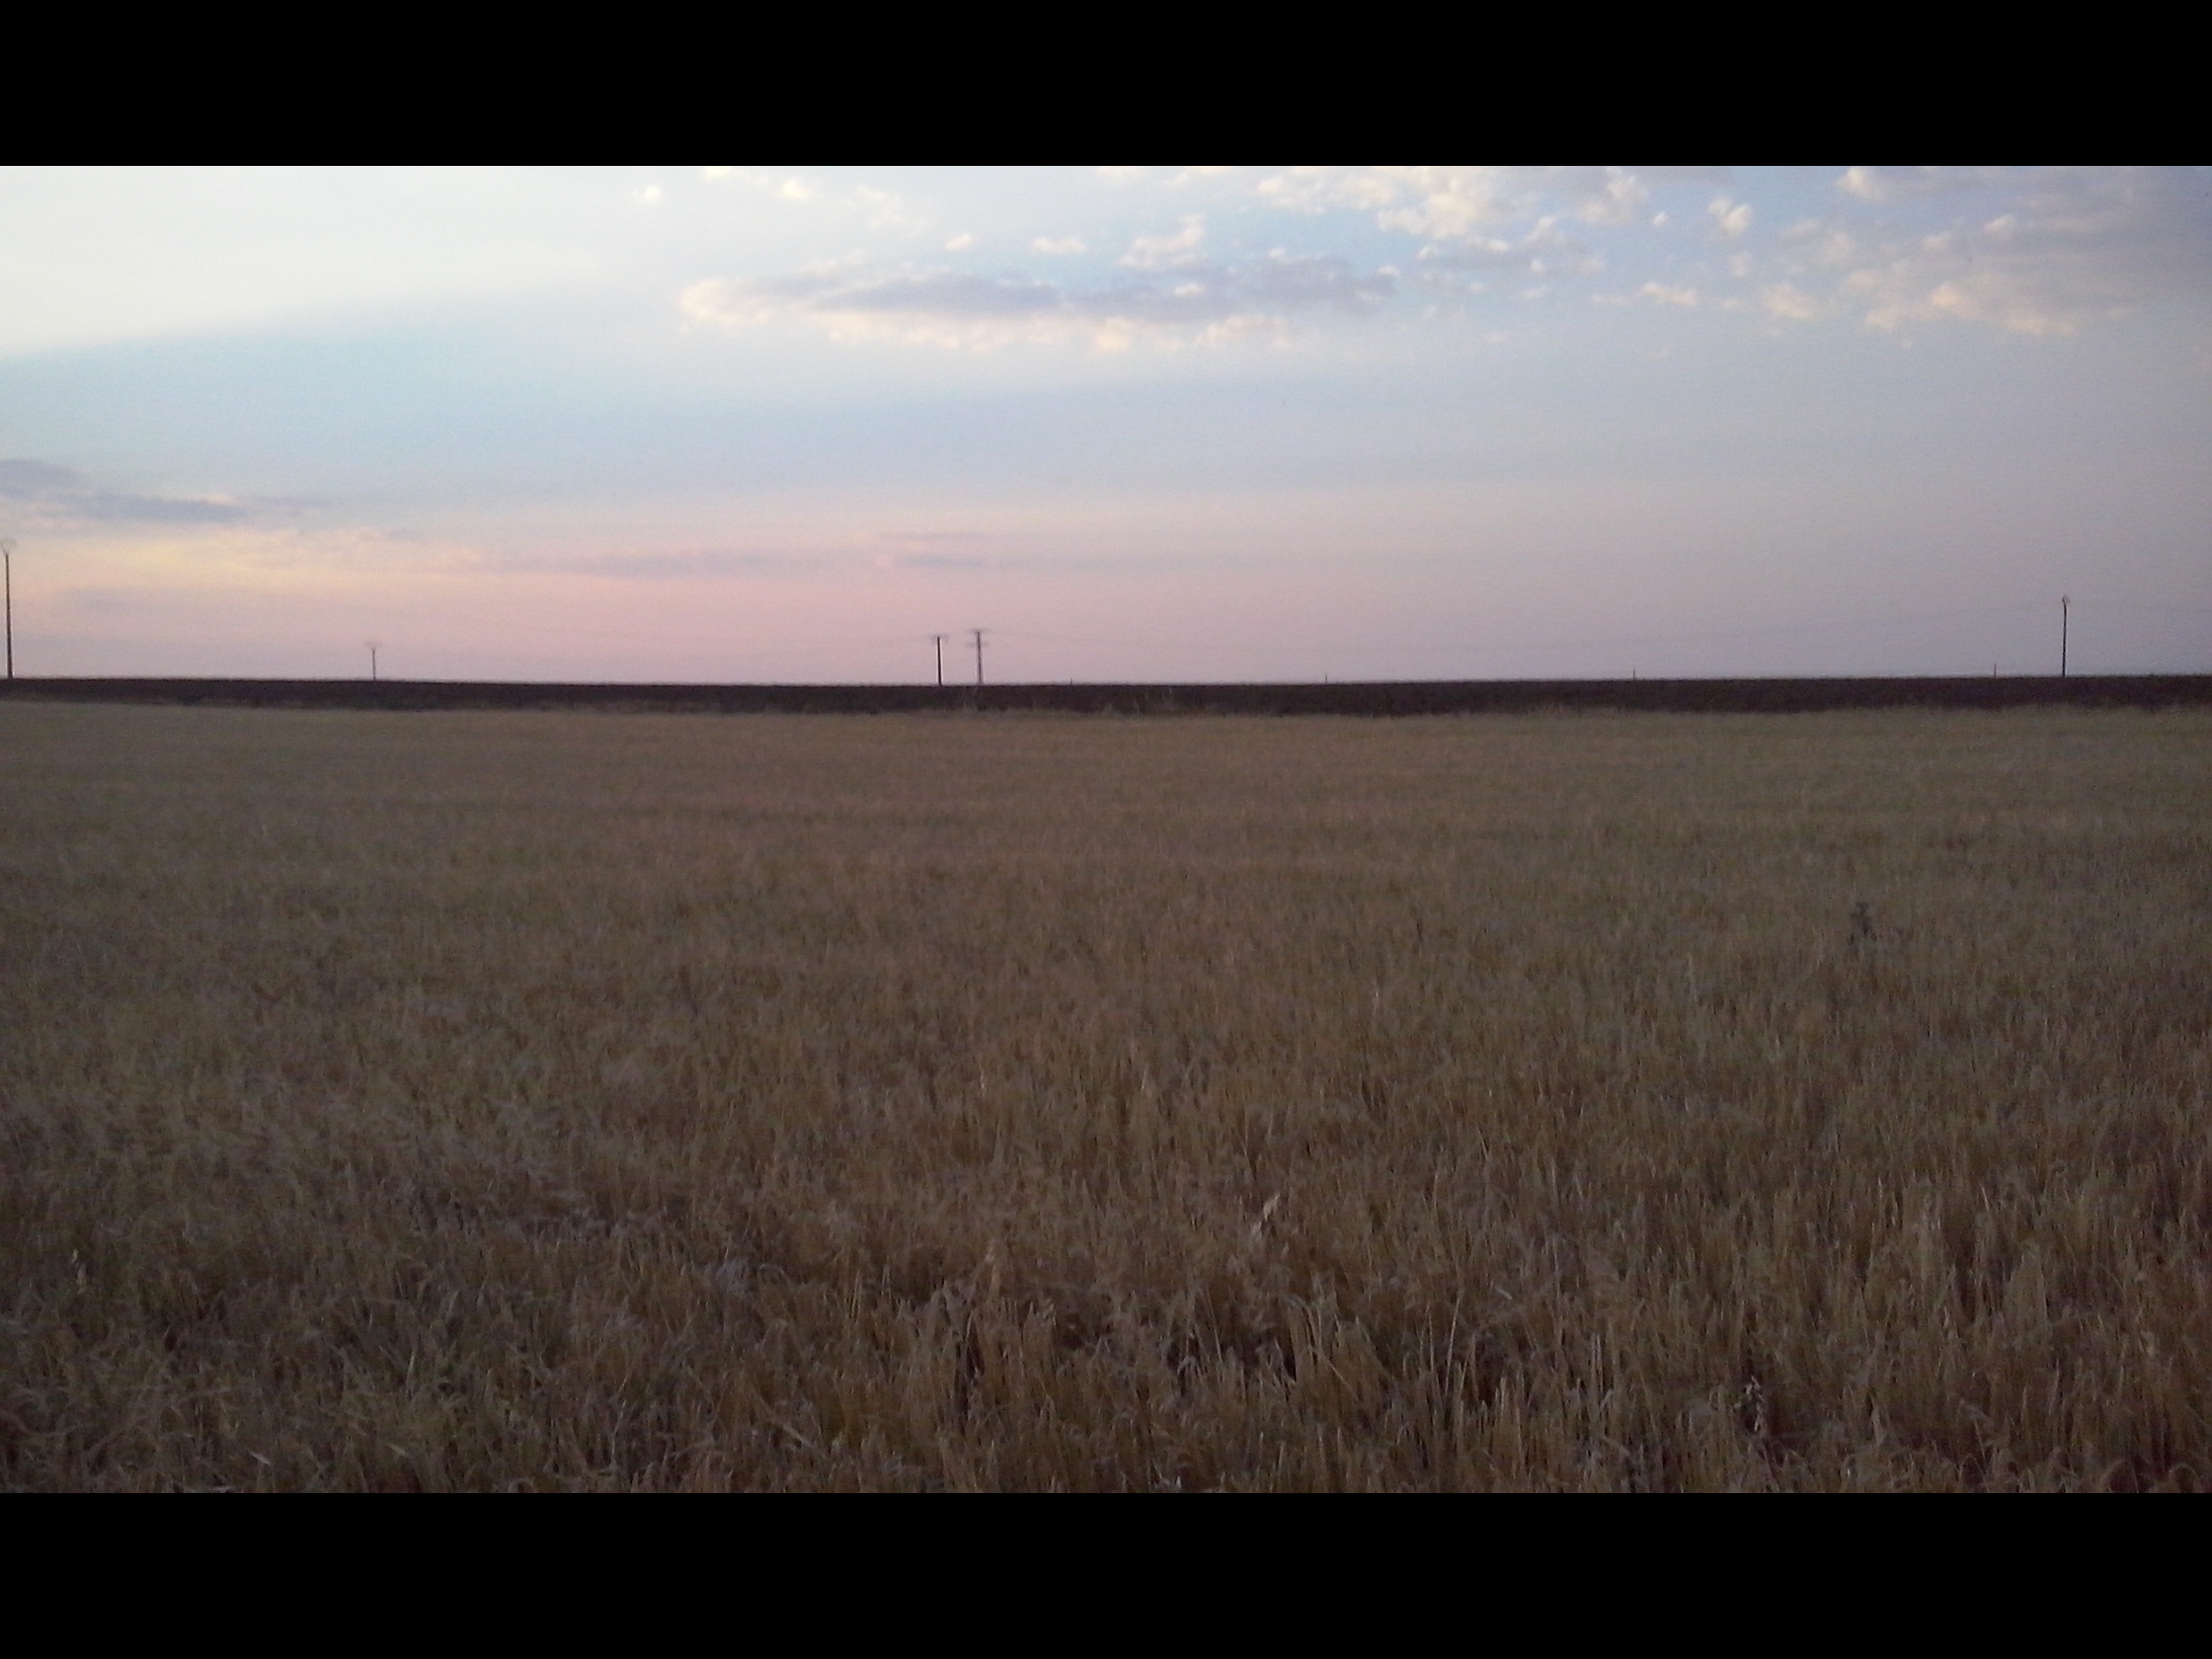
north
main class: Cropland
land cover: Barley
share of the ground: > 75 %
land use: Agriculture (excluding fallow land and kitchen gardens)
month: June
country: ES
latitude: 41.6073
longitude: -5.3308
